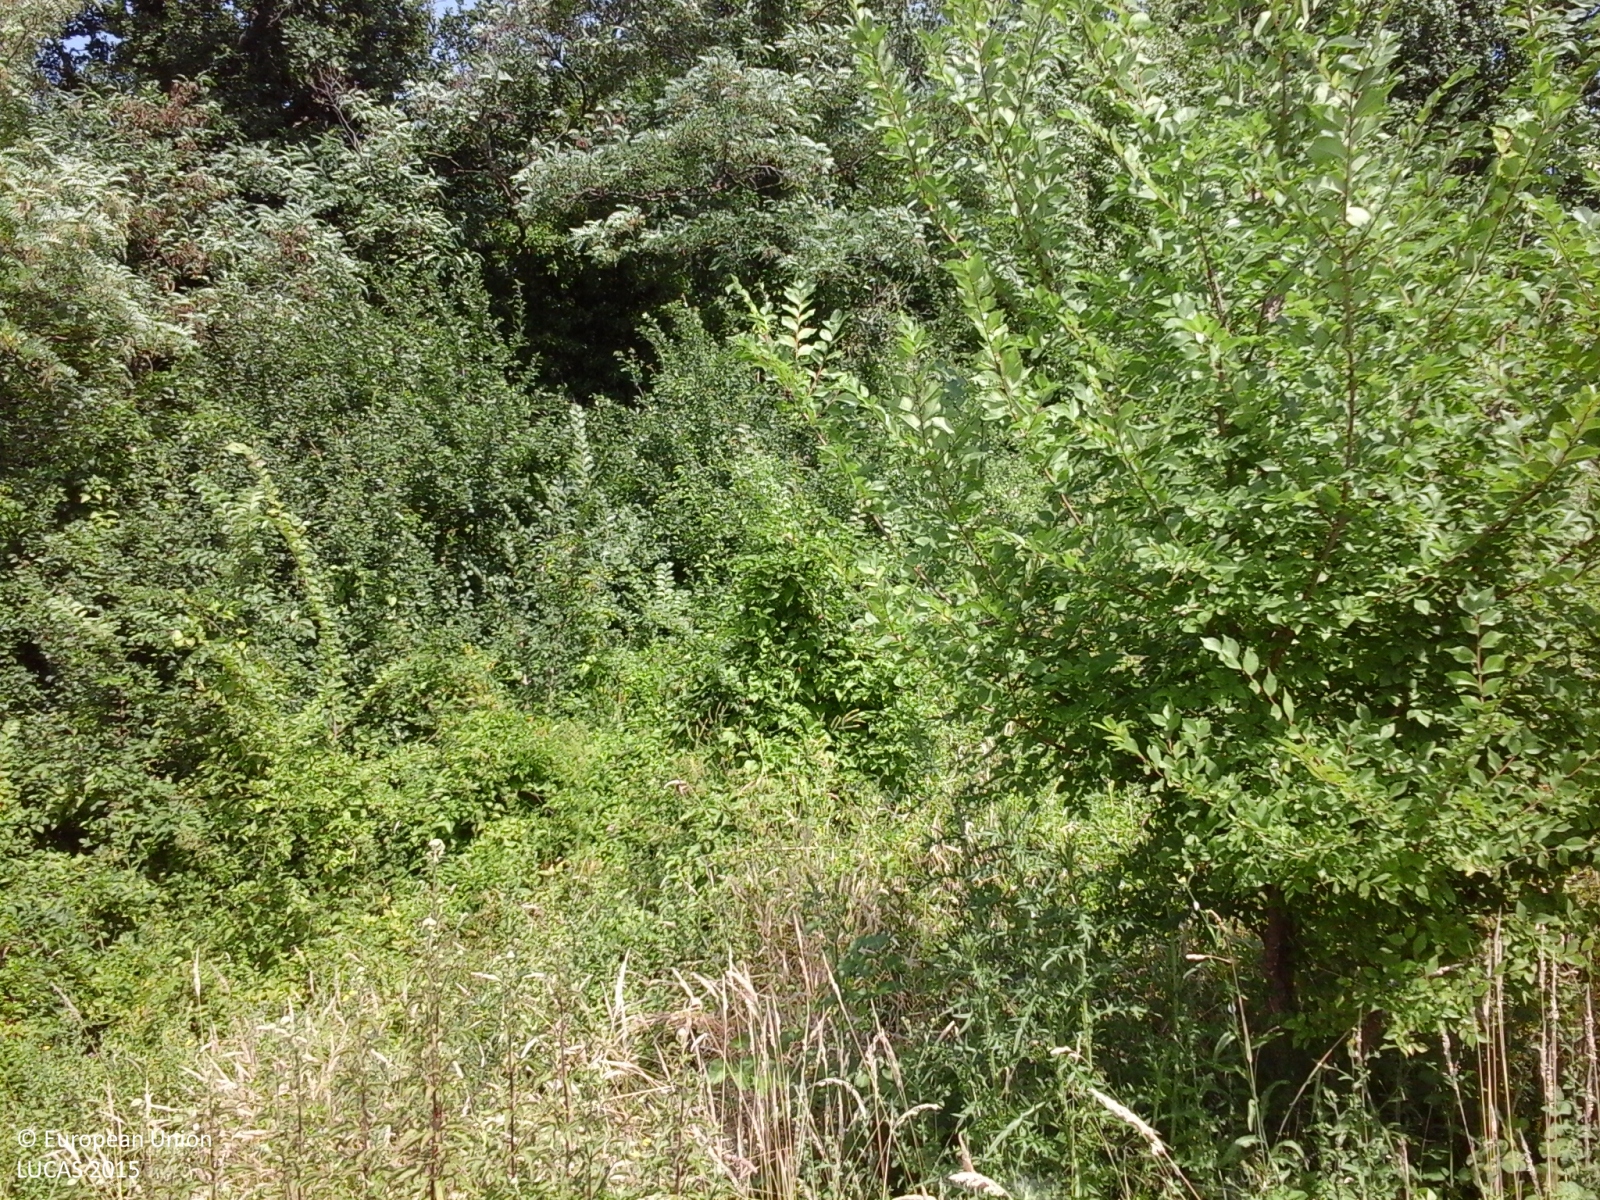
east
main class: Grassland
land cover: Grassland with sparse tree/shrub cover
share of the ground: > 75 %
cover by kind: herbaceous plants 95 %, broadleaved forest trees 5 %
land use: Abandoned areas
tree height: < 5 m
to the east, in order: Grassland with sparse tree/shrub cover; Broadleaved woodland; Electric lines; Broadleaved woodland; Fences; Tracks; Broadleaved woodland; Lucerne; Broadleaved woodland; Lucerne; Spontaneously vegetated surfaces
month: July
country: IT
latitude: 43.0875
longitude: 13.3199
